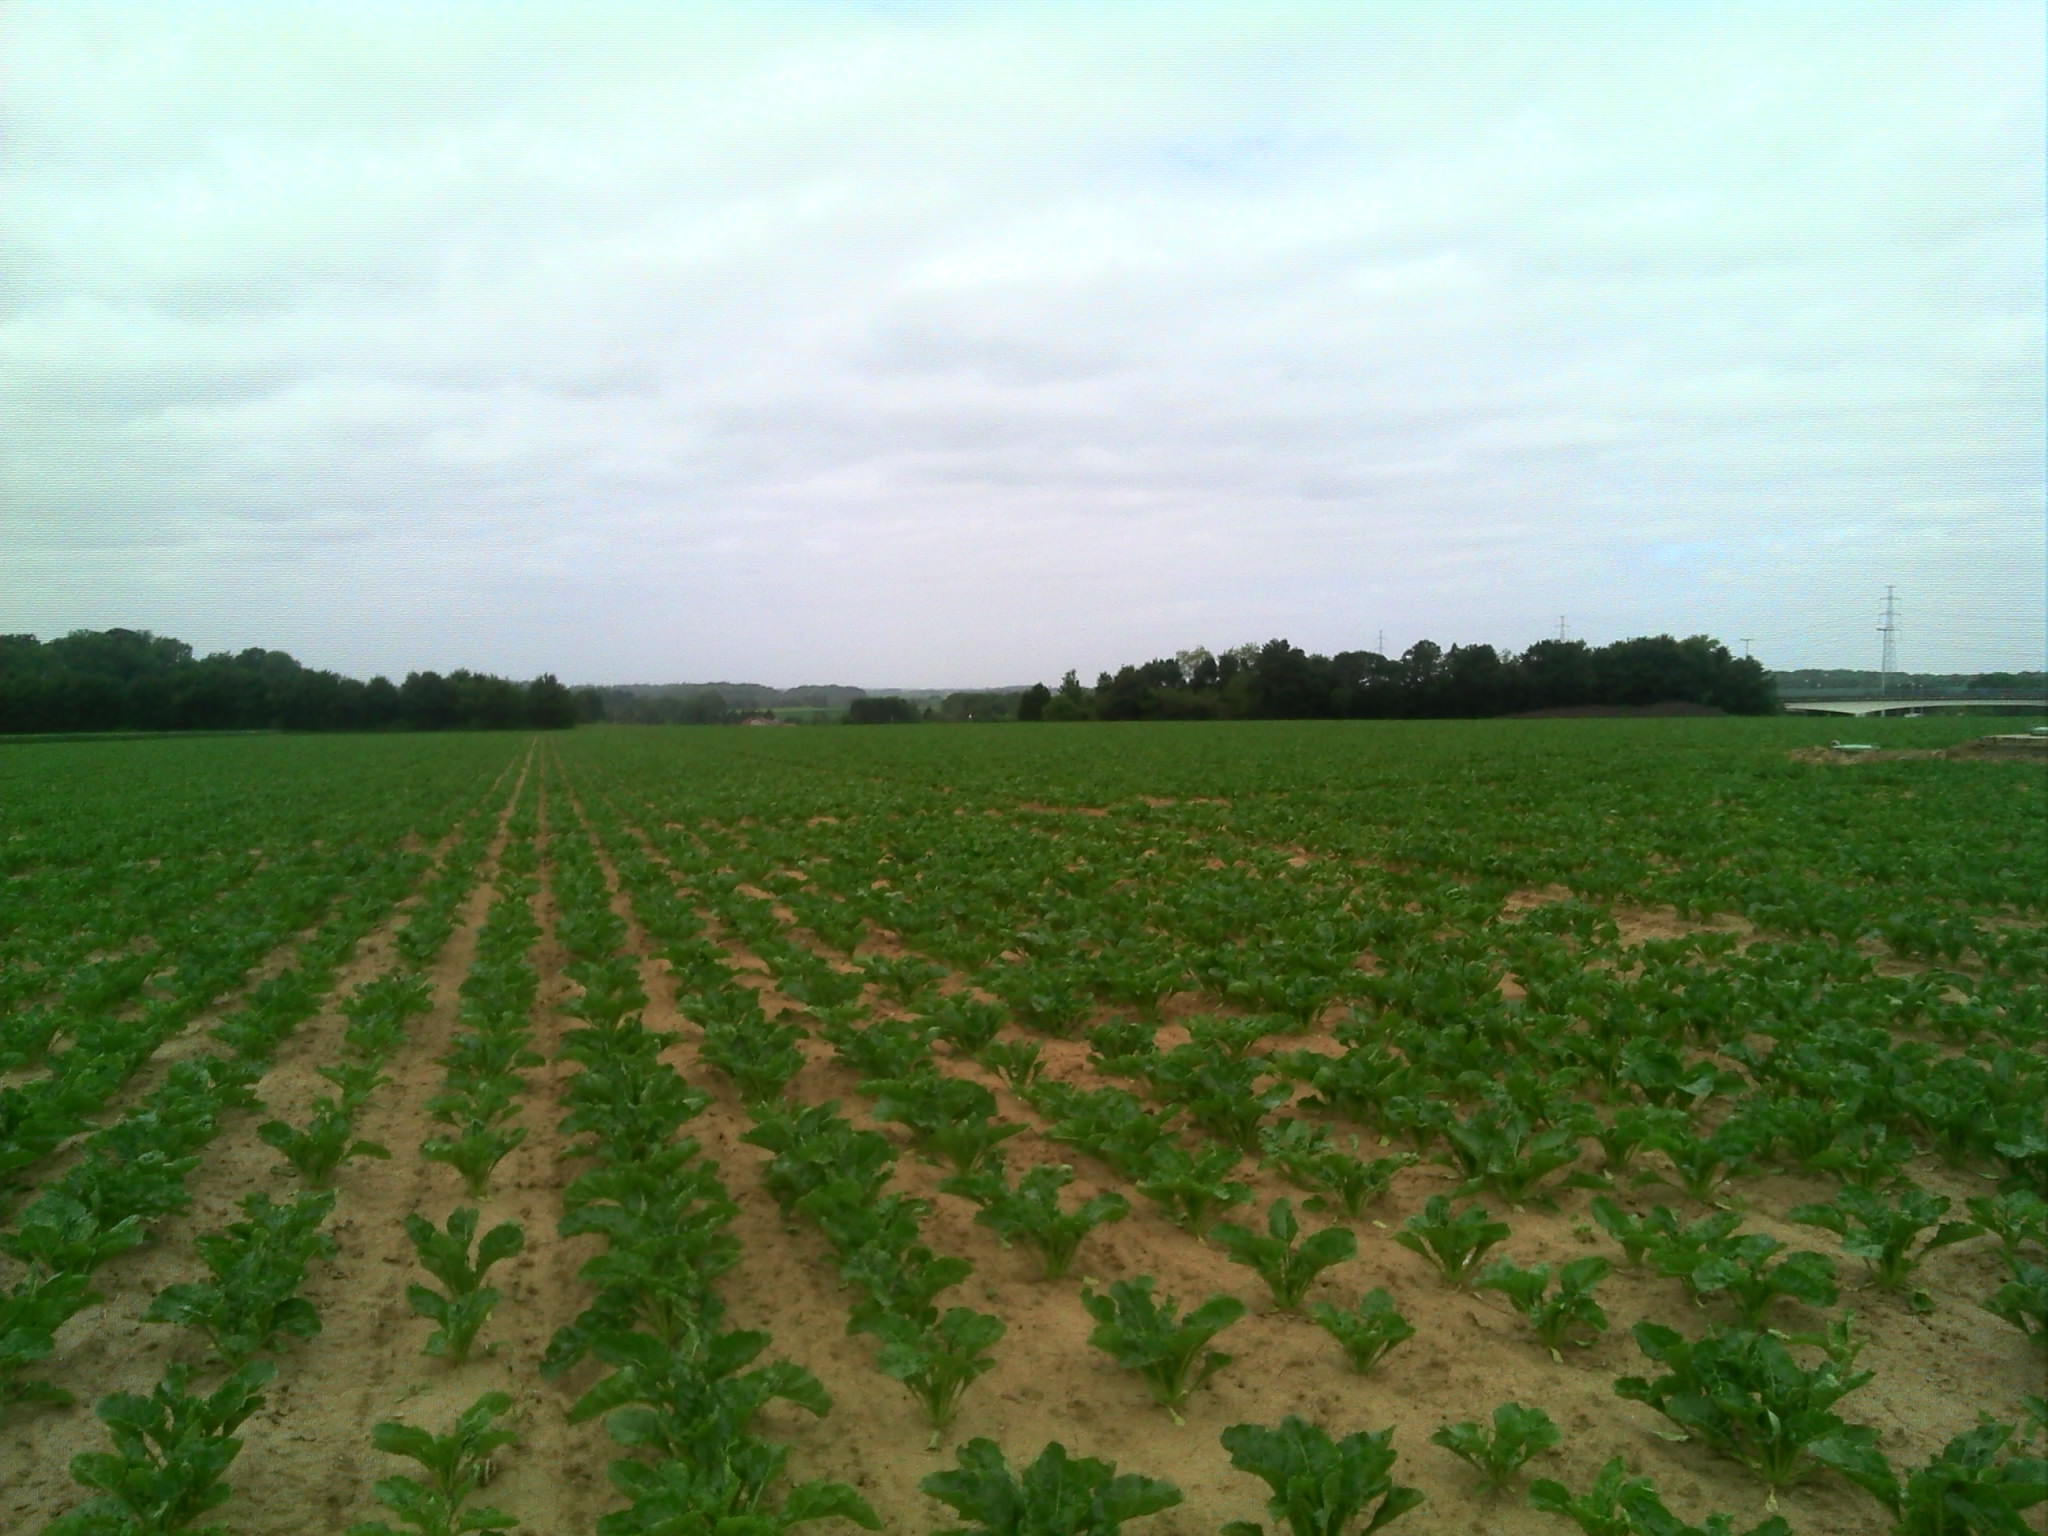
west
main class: Cropland
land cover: Sugar beet
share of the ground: 25 - 50 %
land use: Agriculture (excluding fallow land and kitchen gardens)
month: June
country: BE
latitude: 50.4940
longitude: 4.7102
